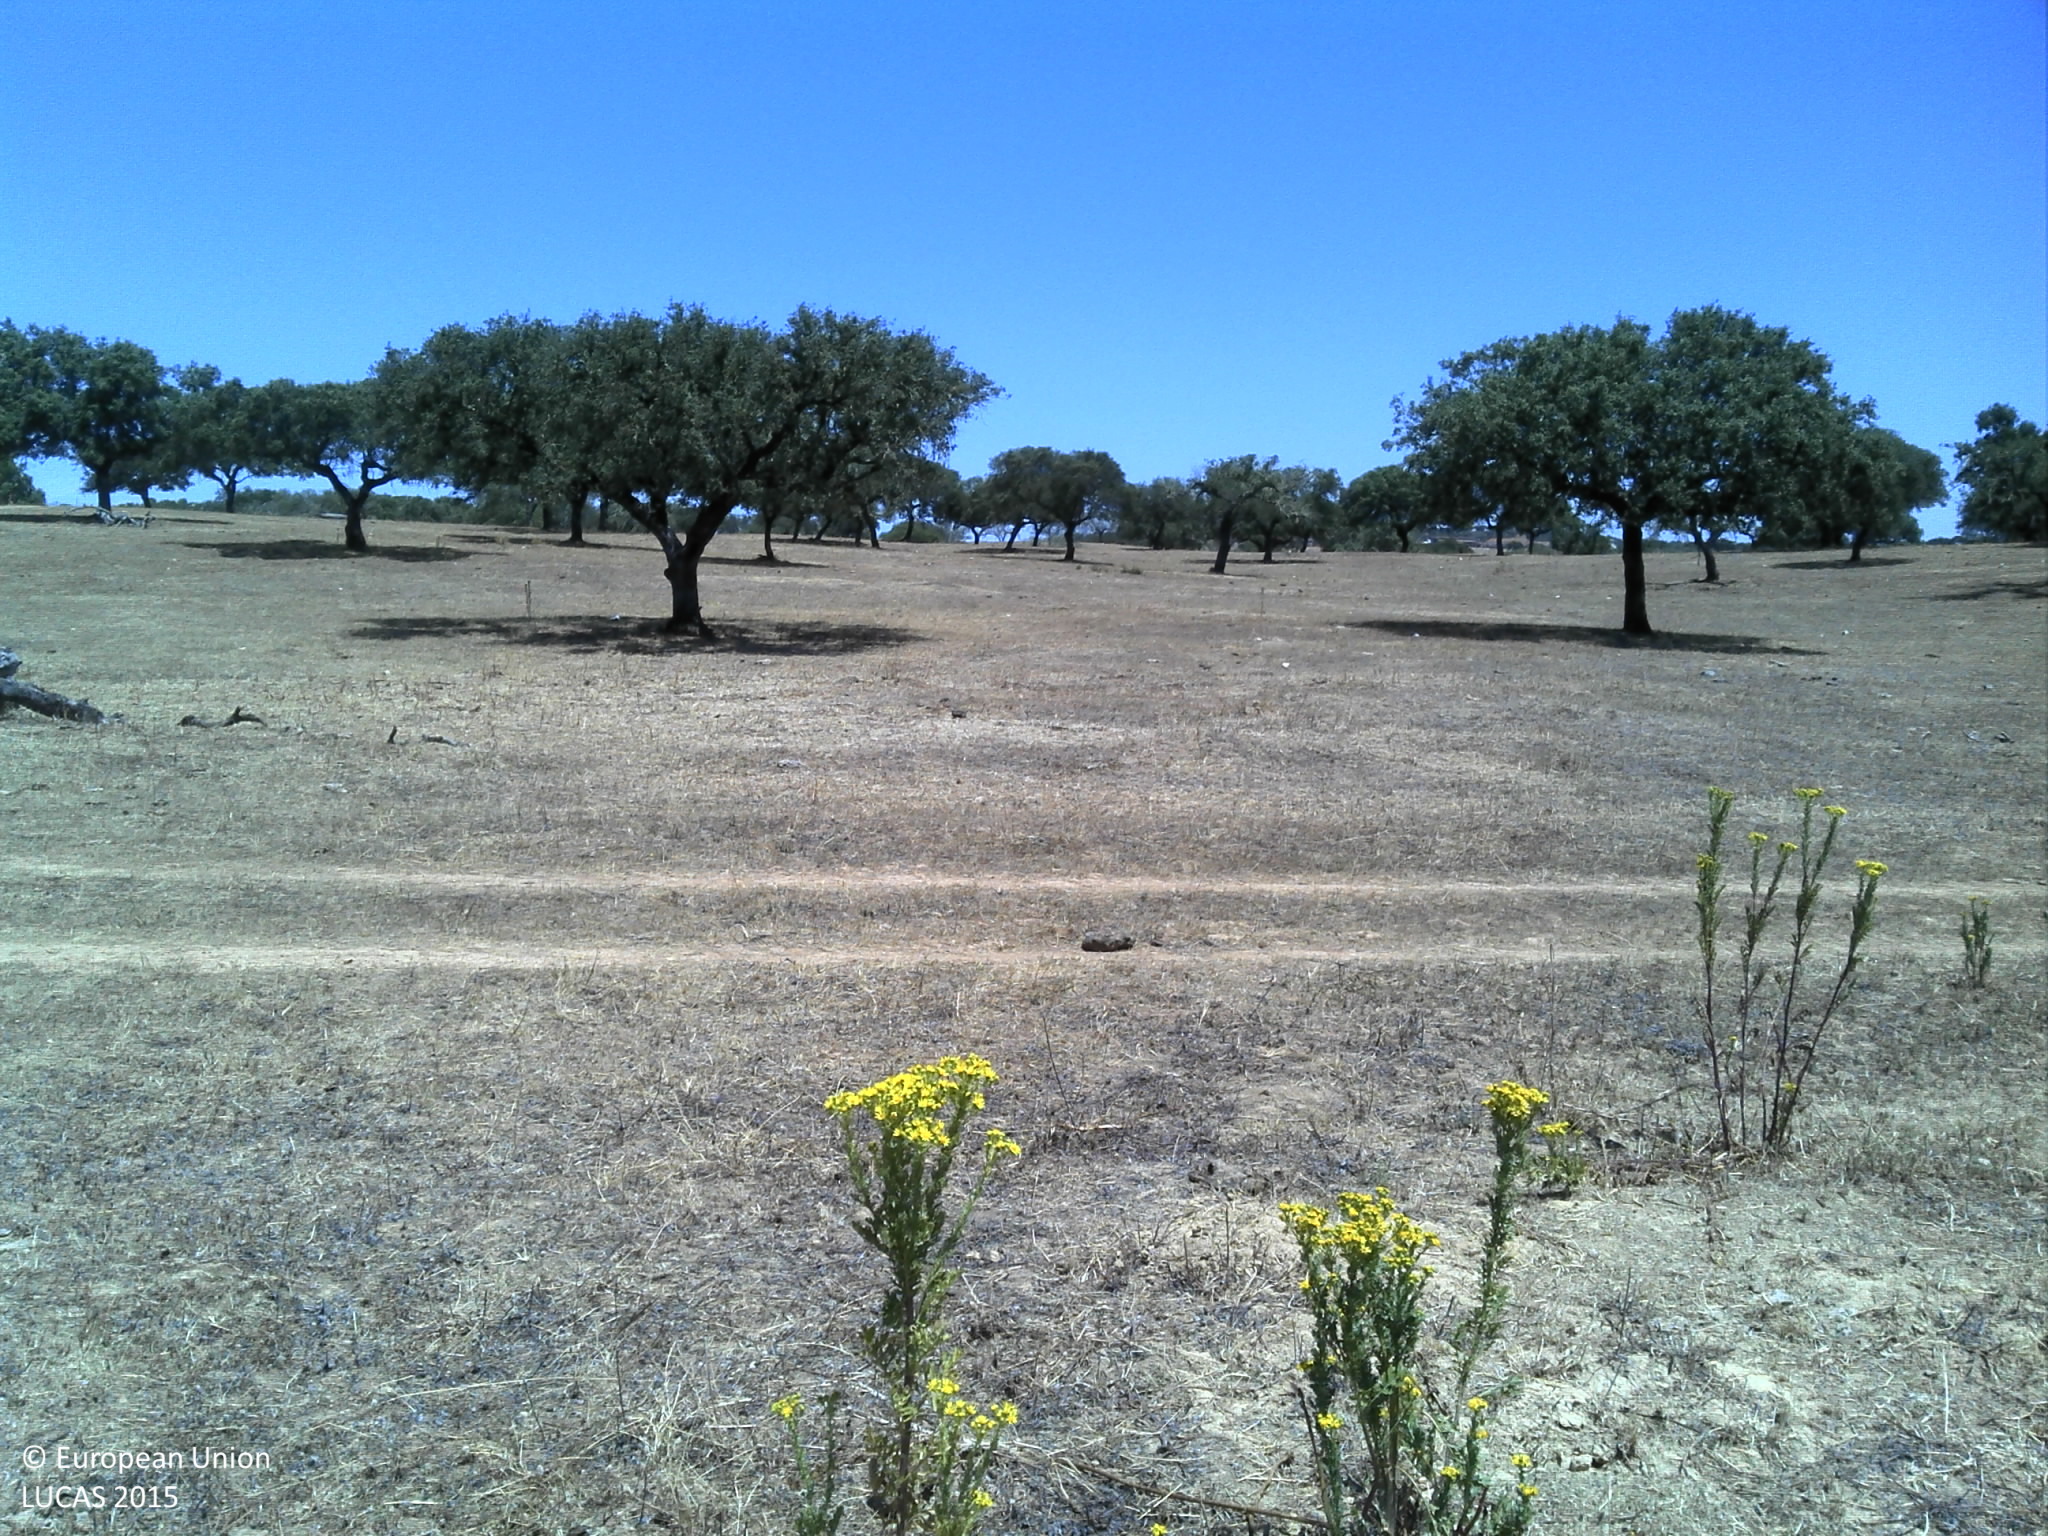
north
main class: Grassland
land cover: Grassland without tree/shrub cover
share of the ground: 25 - 50 %
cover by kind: unconsolidated bare surface 70 %, herbaceous plants 30 %
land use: Agriculture (excluding fallow land and kitchen gardens)
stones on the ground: < 10 %
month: June
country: PT
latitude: 37.8834
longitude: -7.5155
